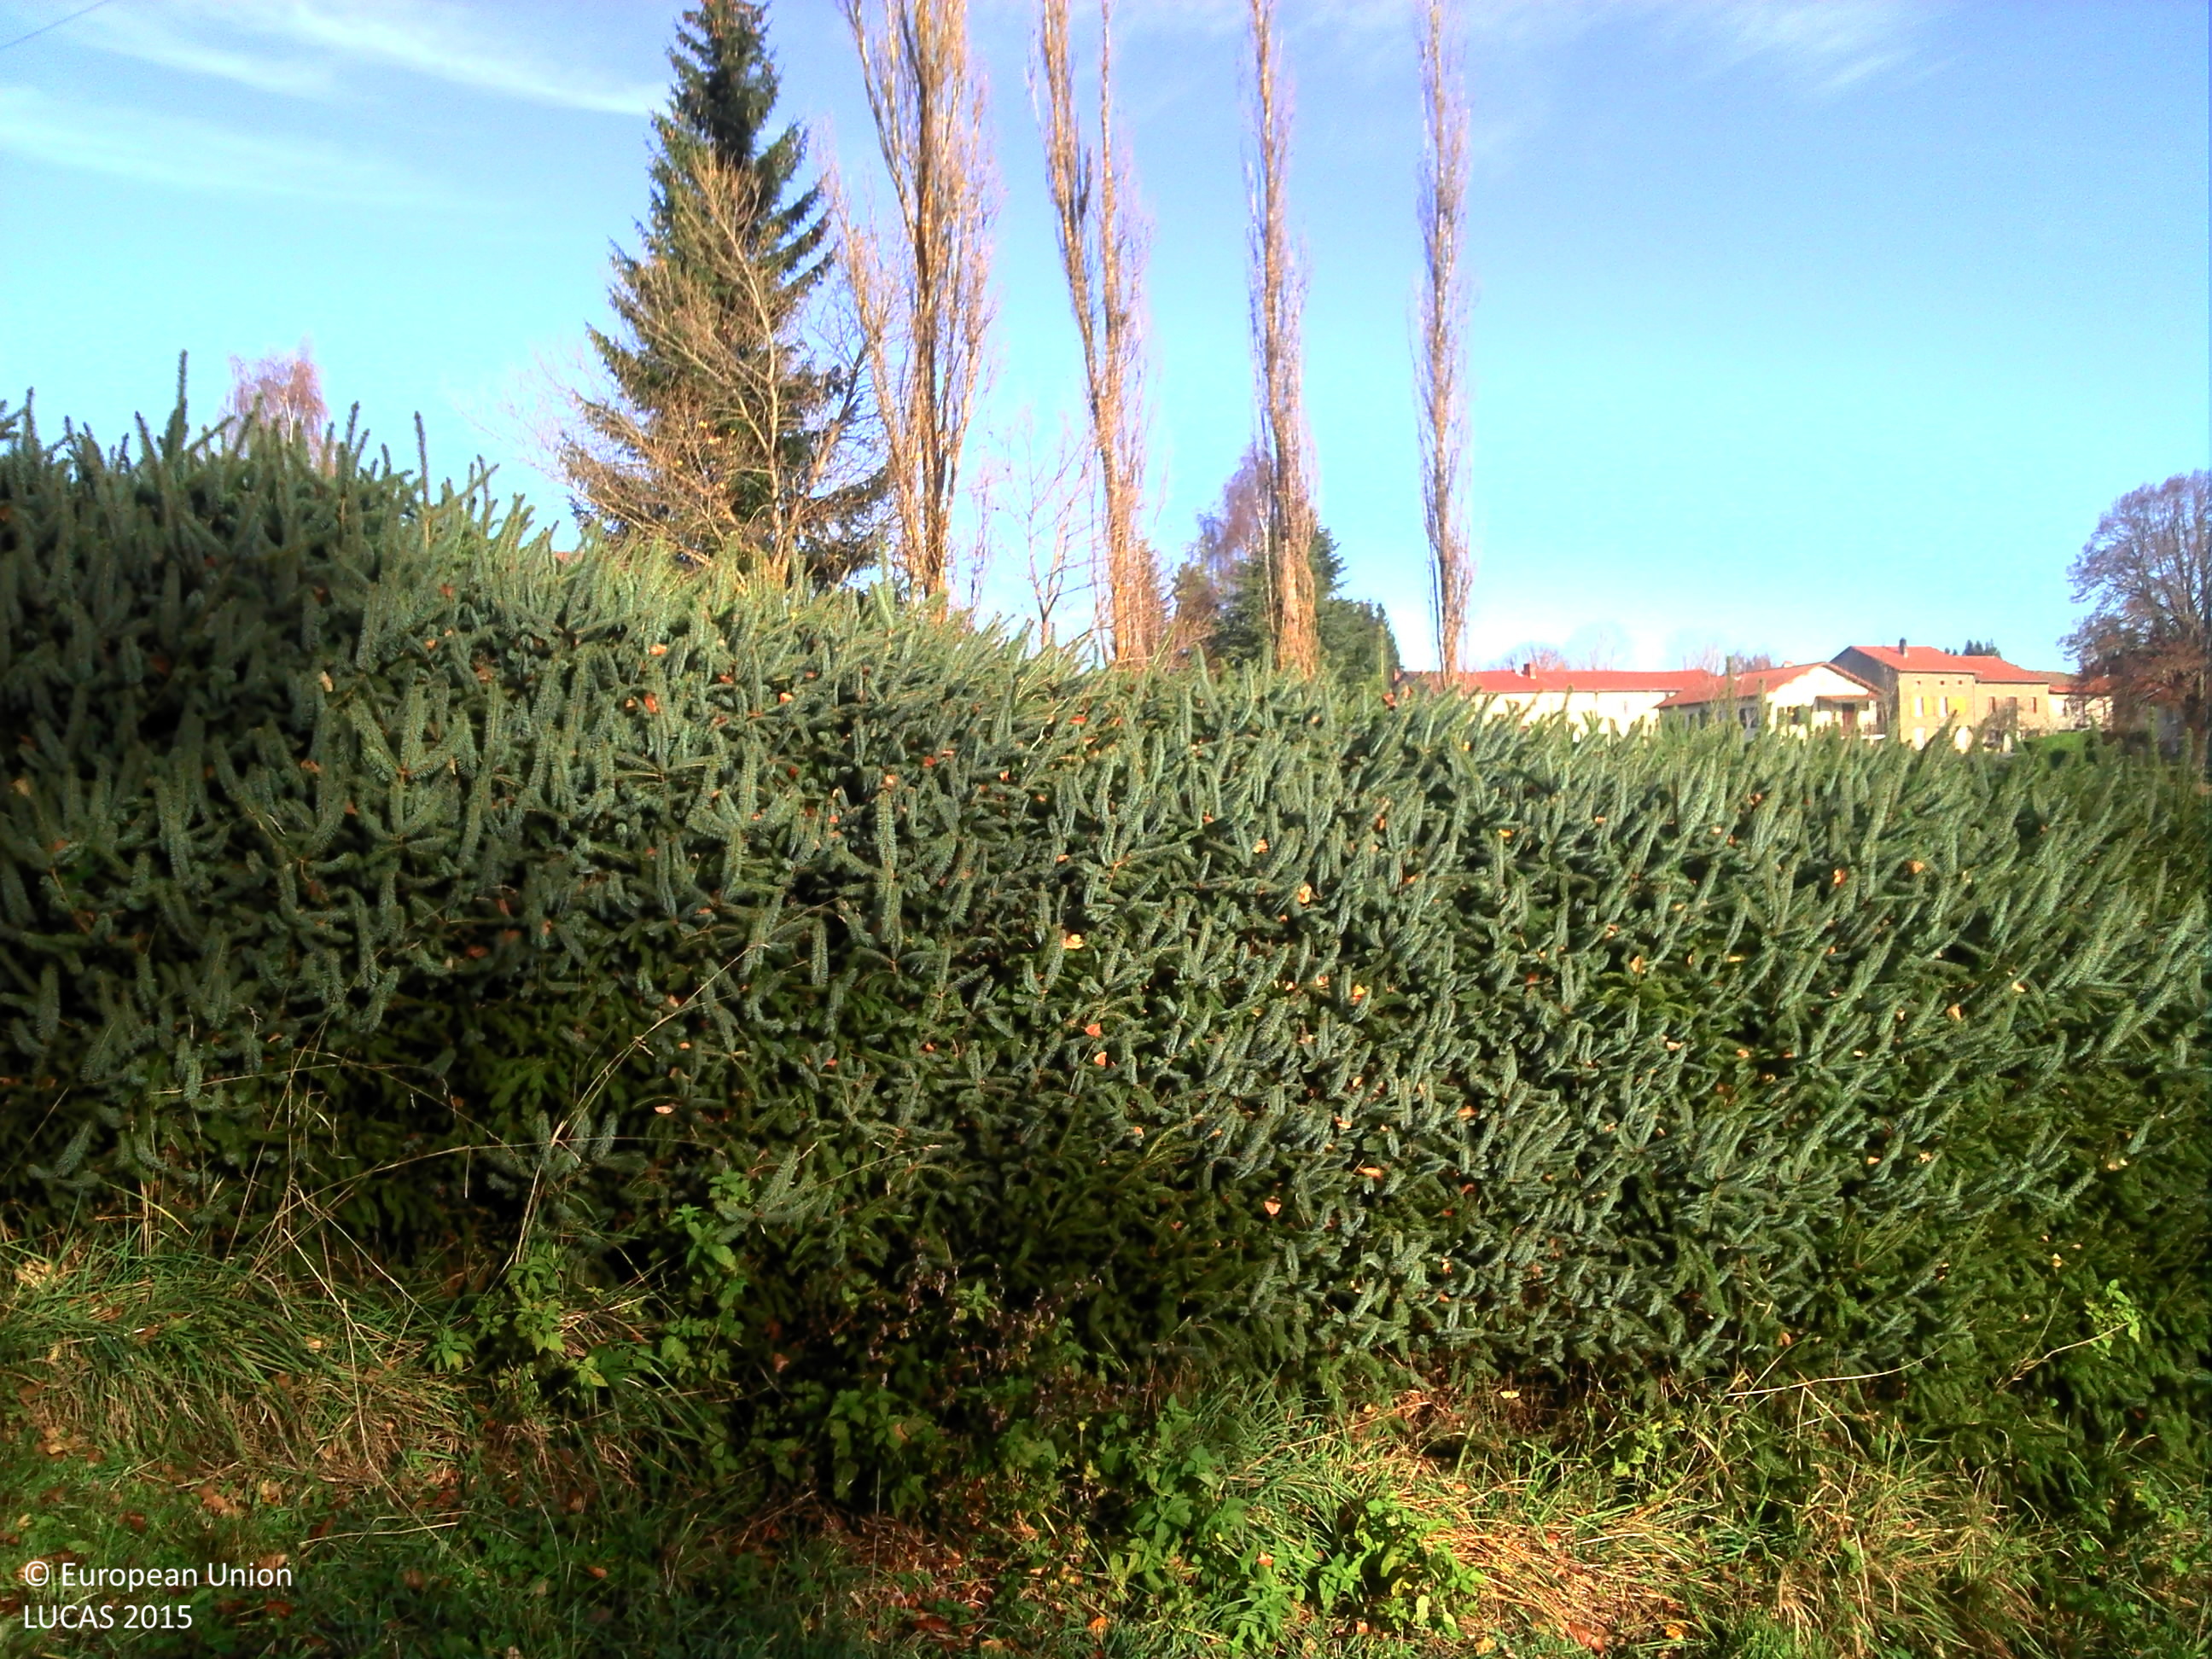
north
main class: Grassland
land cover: Grassland without tree/shrub cover
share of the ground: > 75 %
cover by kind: herbaceous plants 100 %
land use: Agriculture (excluding fallow land and kitchen gardens)
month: November
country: FR
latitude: 45.3246
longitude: 3.8410
